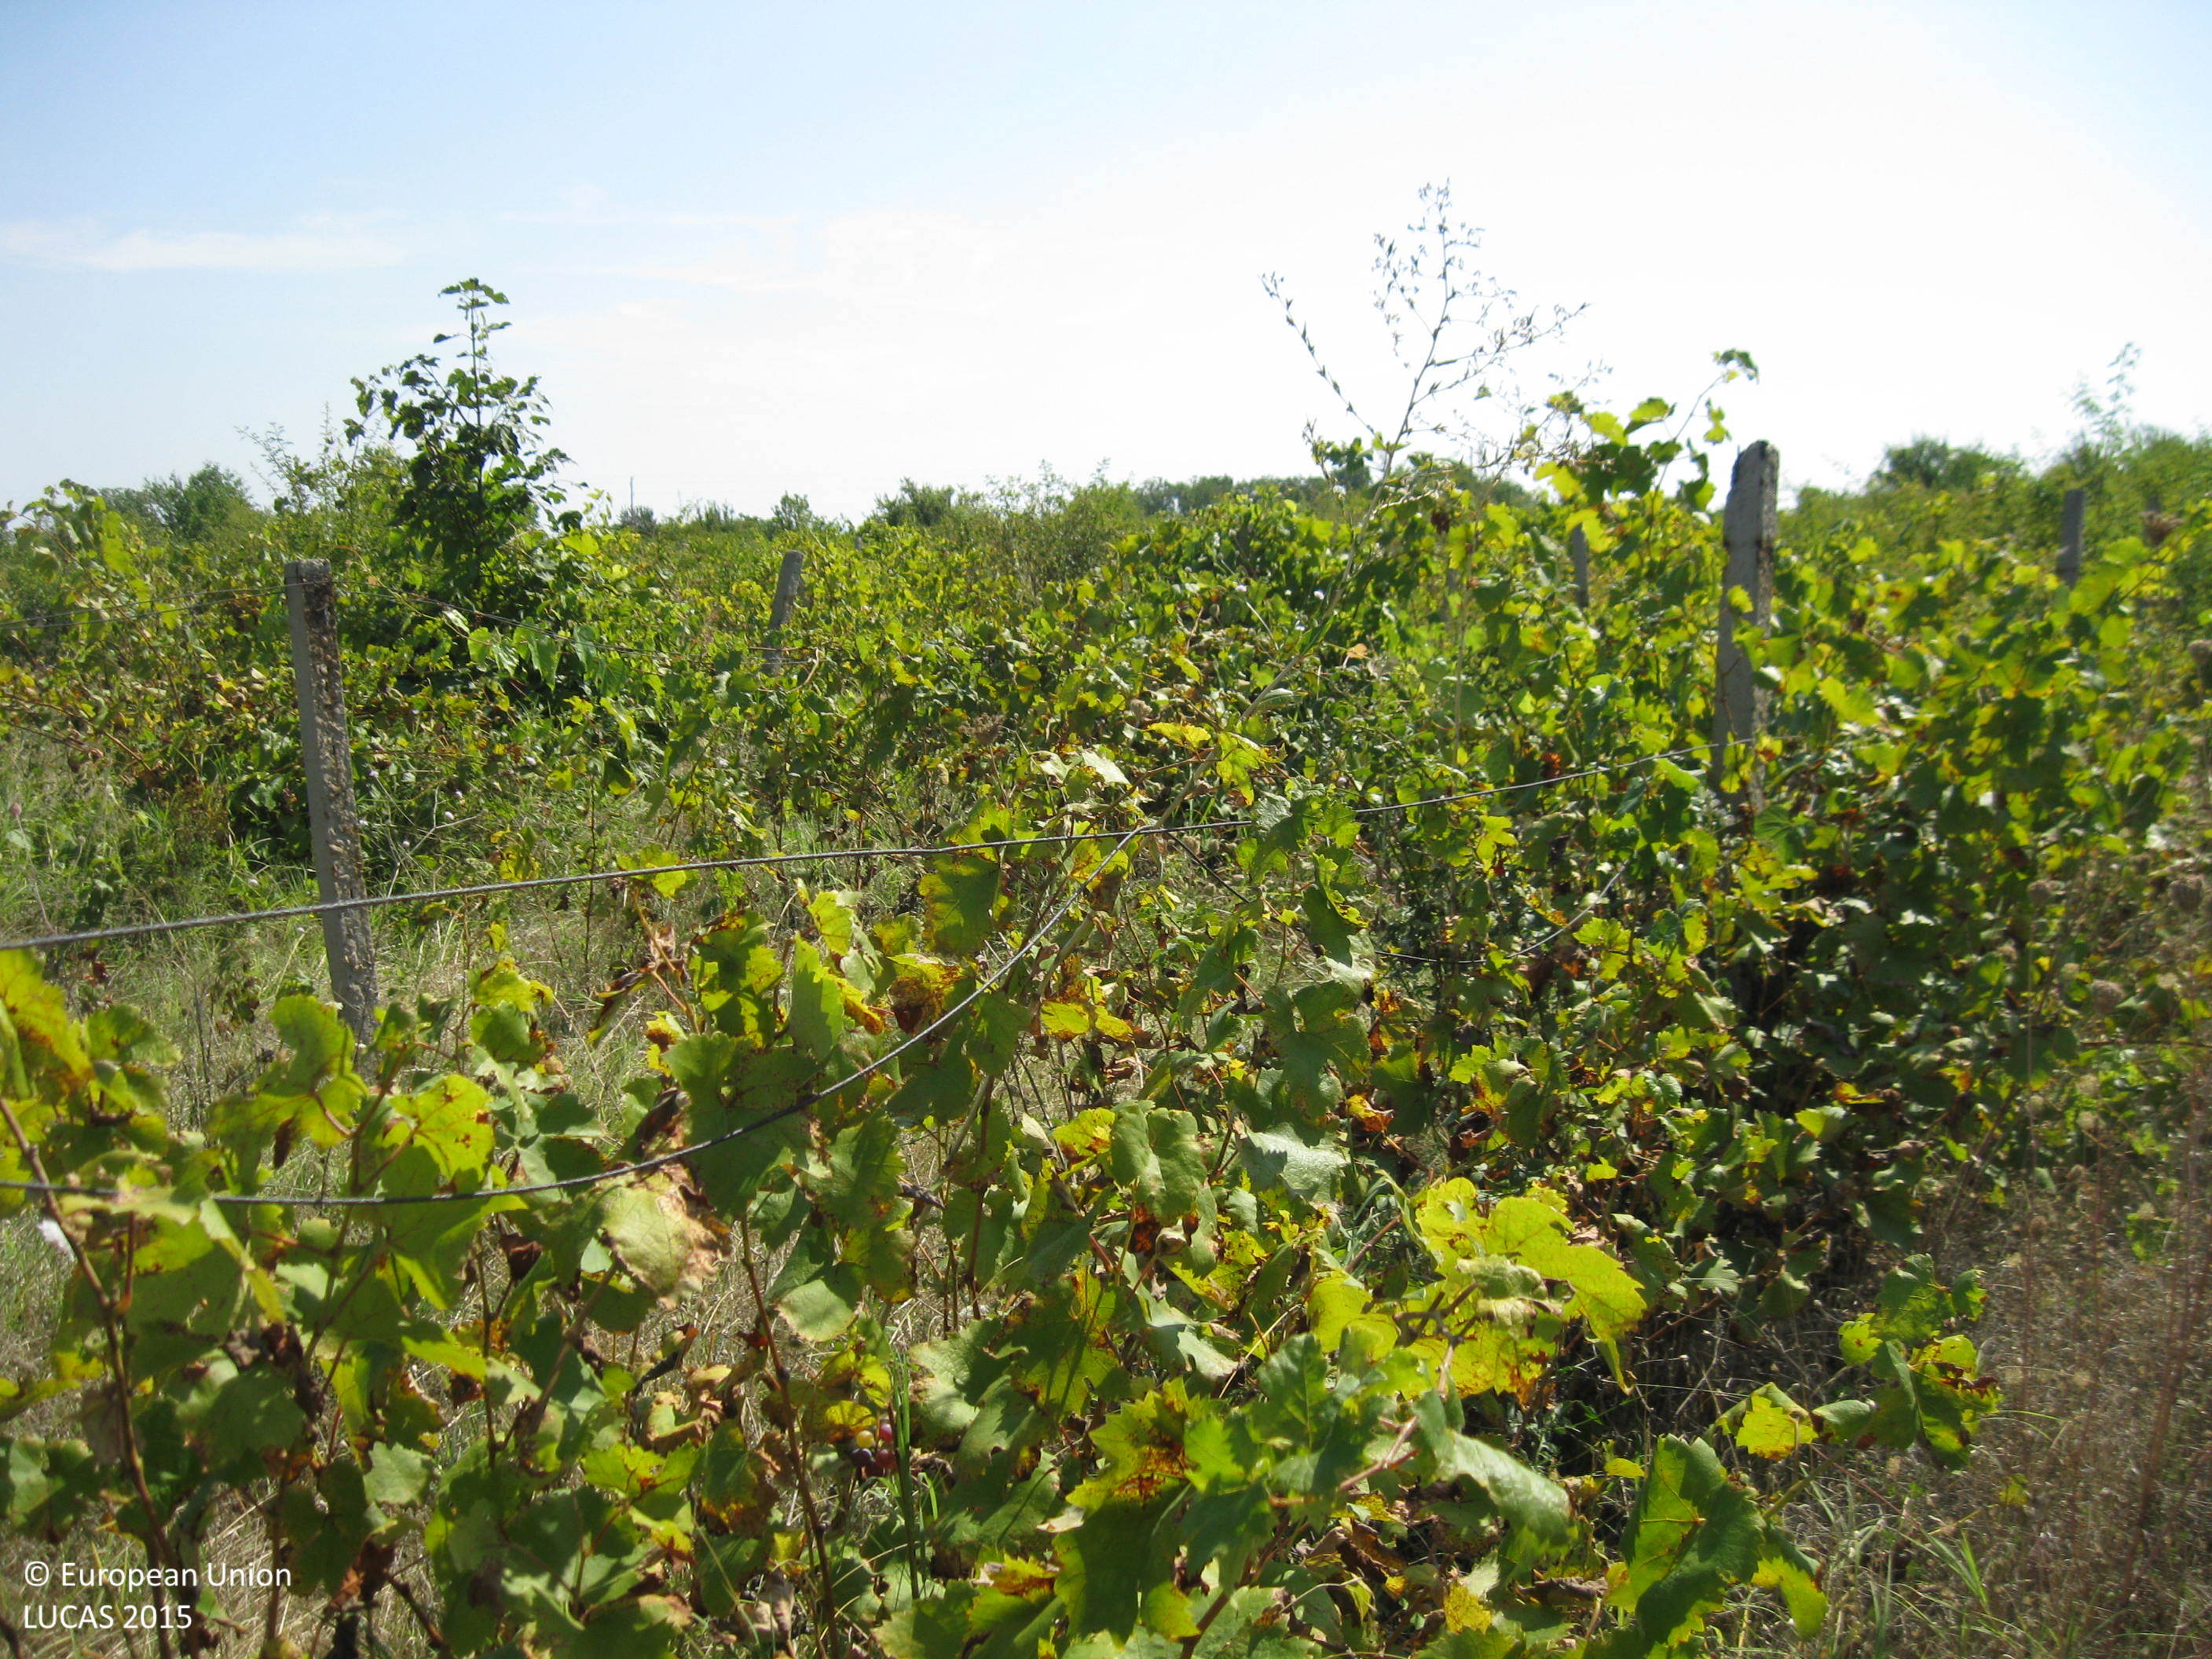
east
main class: Cropland
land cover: Vineyards
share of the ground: 25 - 50 %
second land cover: Spontaneously vegetated surfaces
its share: > 75 %
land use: Agriculture (excluding fallow land and kitchen gardens)
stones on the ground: < 10 %
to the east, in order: Vineyards; Spontaneously vegetated surfaces; Tracks; Vineyards
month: August
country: BG
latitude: 41.9798
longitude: 24.9339
